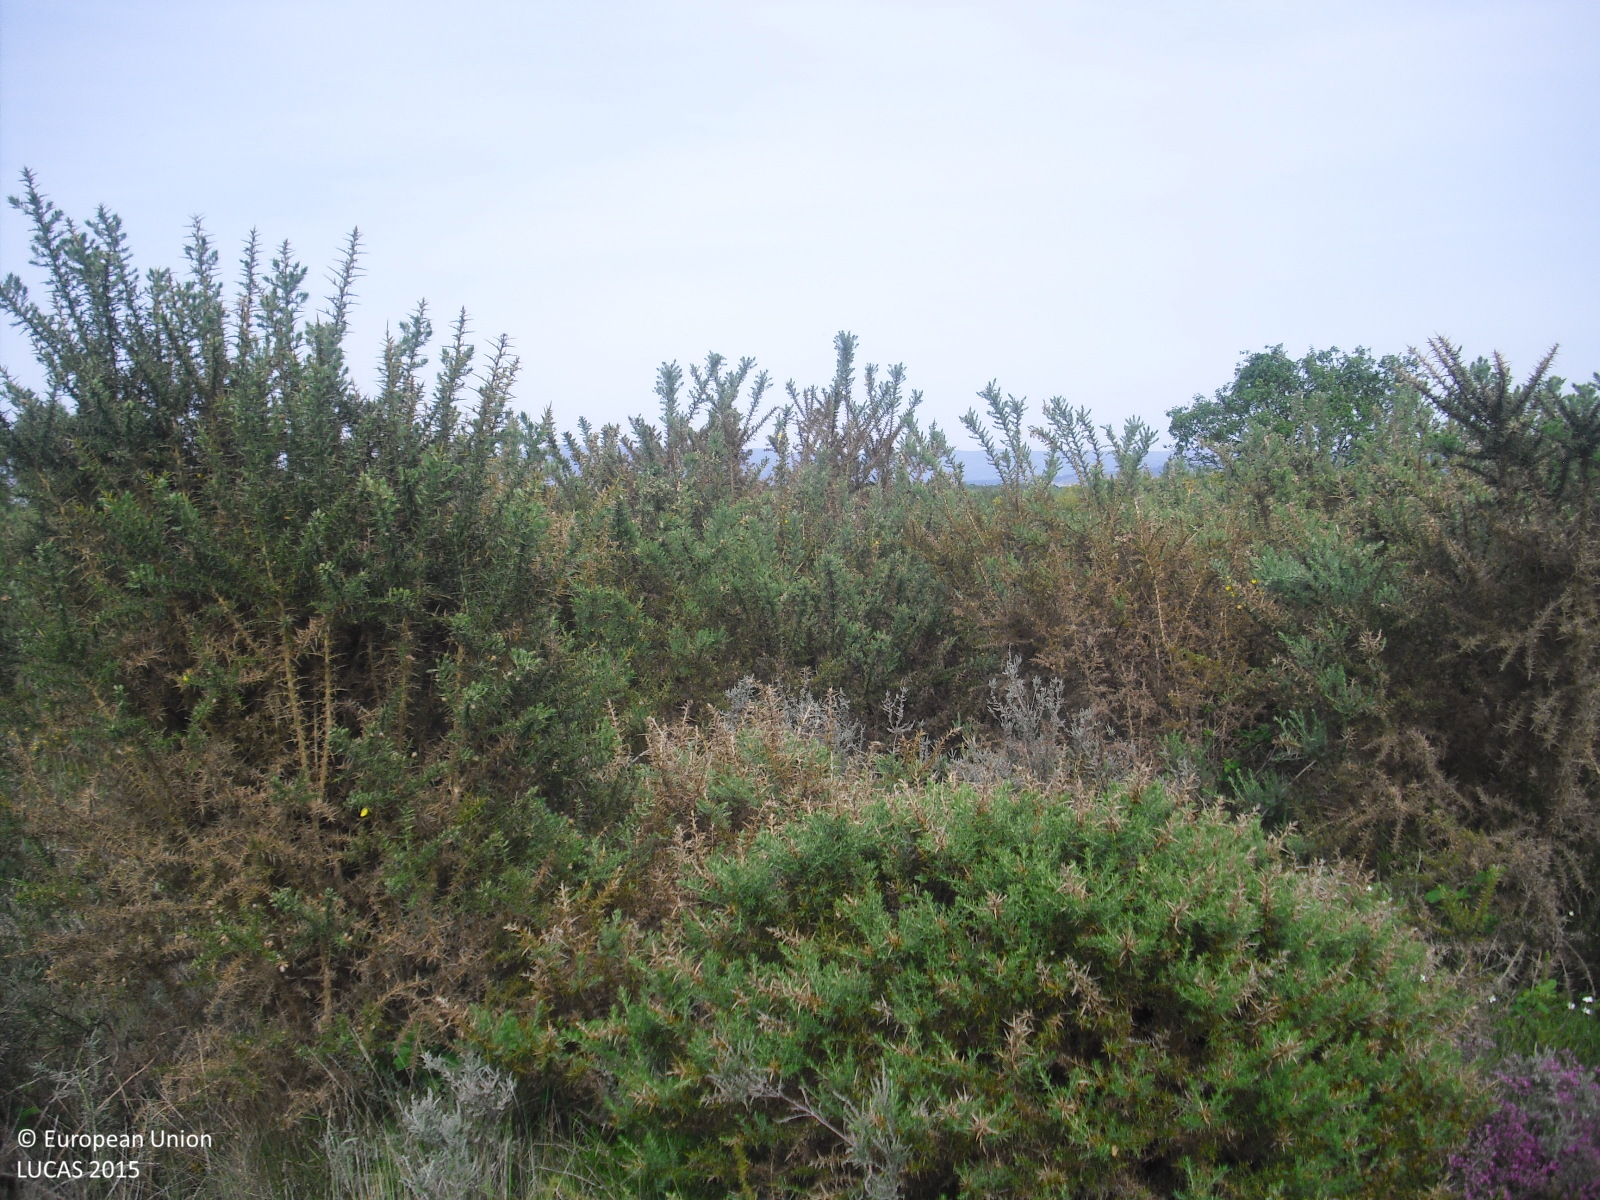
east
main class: Shrubland
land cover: Shrubland without tree cover
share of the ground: > 75 %
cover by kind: shrubs 100 %
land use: Semi-natural and natural areas not in use
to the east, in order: Shrubland without tree cover; Ditches and canals; Shruby margins; Tracks; Shruby margins; Tracks; Grass margins; Common wheat; Shrubland without tree cover; Single bushes/trees; Shrubland with sparse tree cover
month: May
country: ES
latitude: 42.1632
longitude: -7.7304
